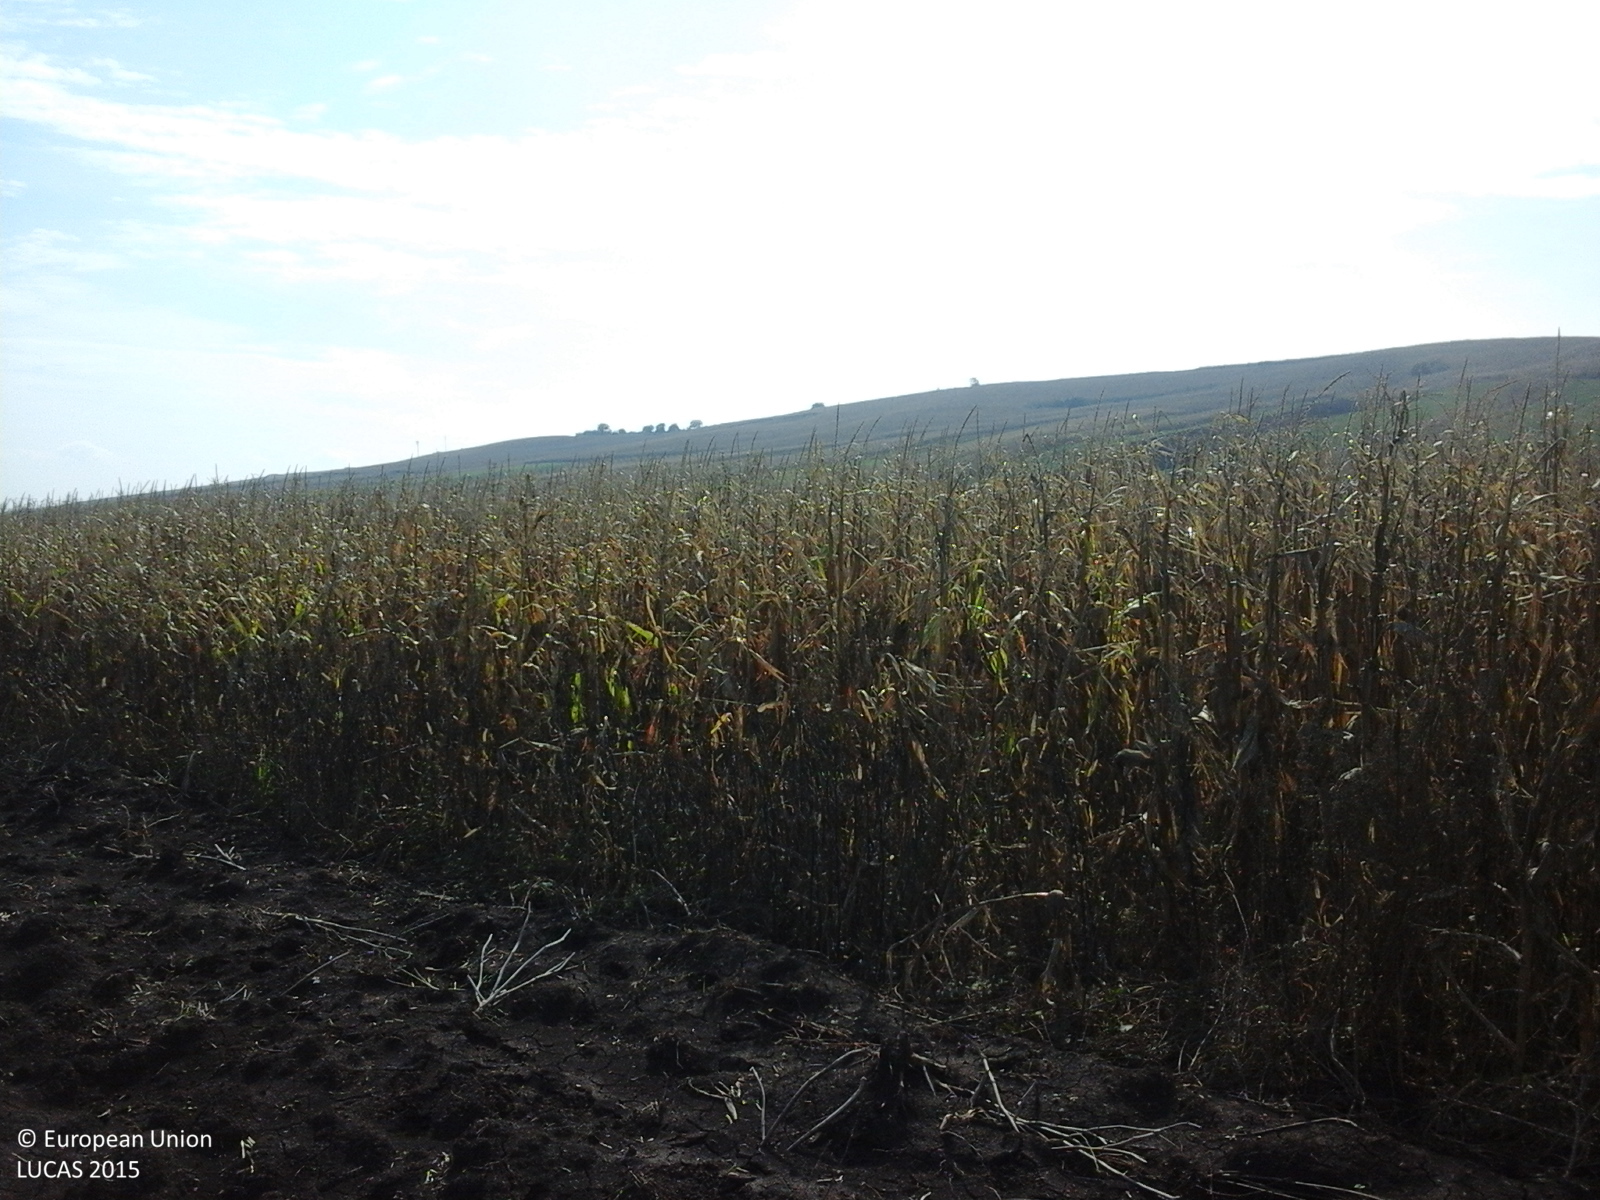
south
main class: Cropland
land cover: Rape and turnip rape
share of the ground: < 10 %
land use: Agriculture (excluding fallow land and kitchen gardens)
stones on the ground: < 10 %
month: October
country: RO
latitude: 46.5044
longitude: 23.8481
